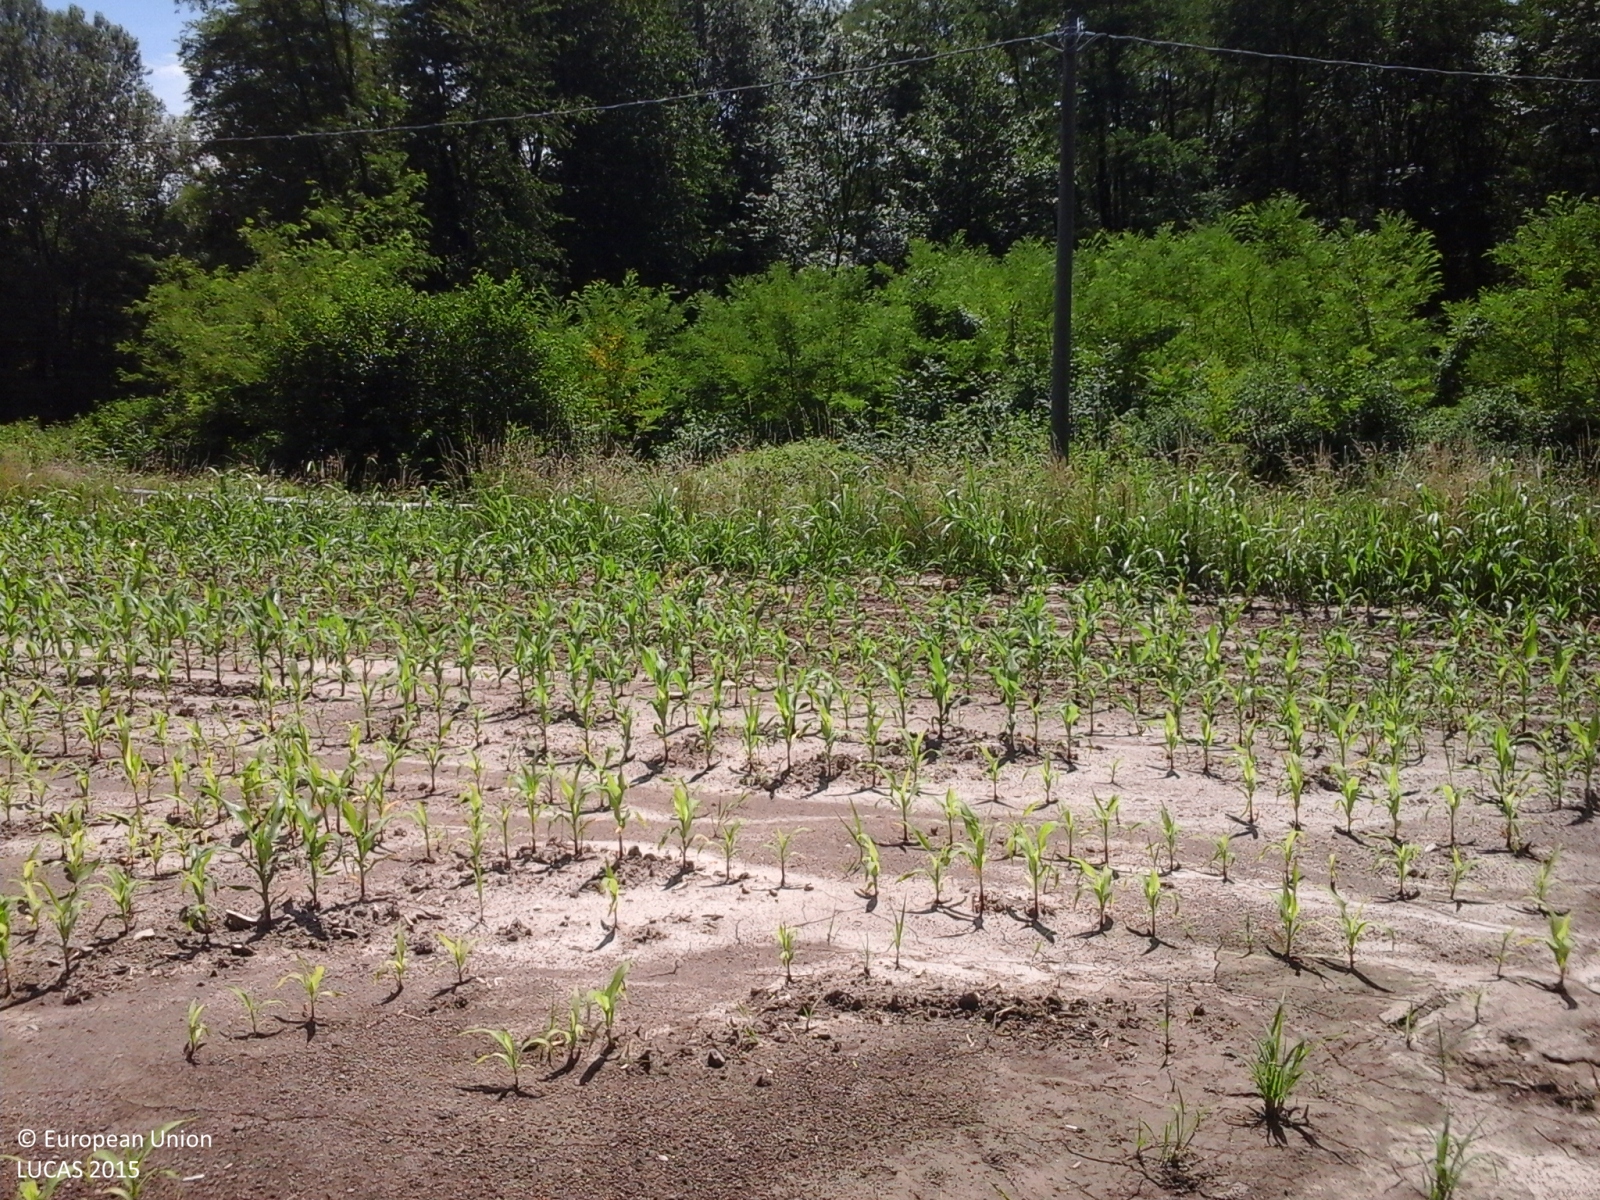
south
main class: Cropland
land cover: Maize
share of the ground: 25 - 50 %
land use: Agriculture (excluding fallow land and kitchen gardens)
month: June
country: IT
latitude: 45.8559
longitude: 8.6240
